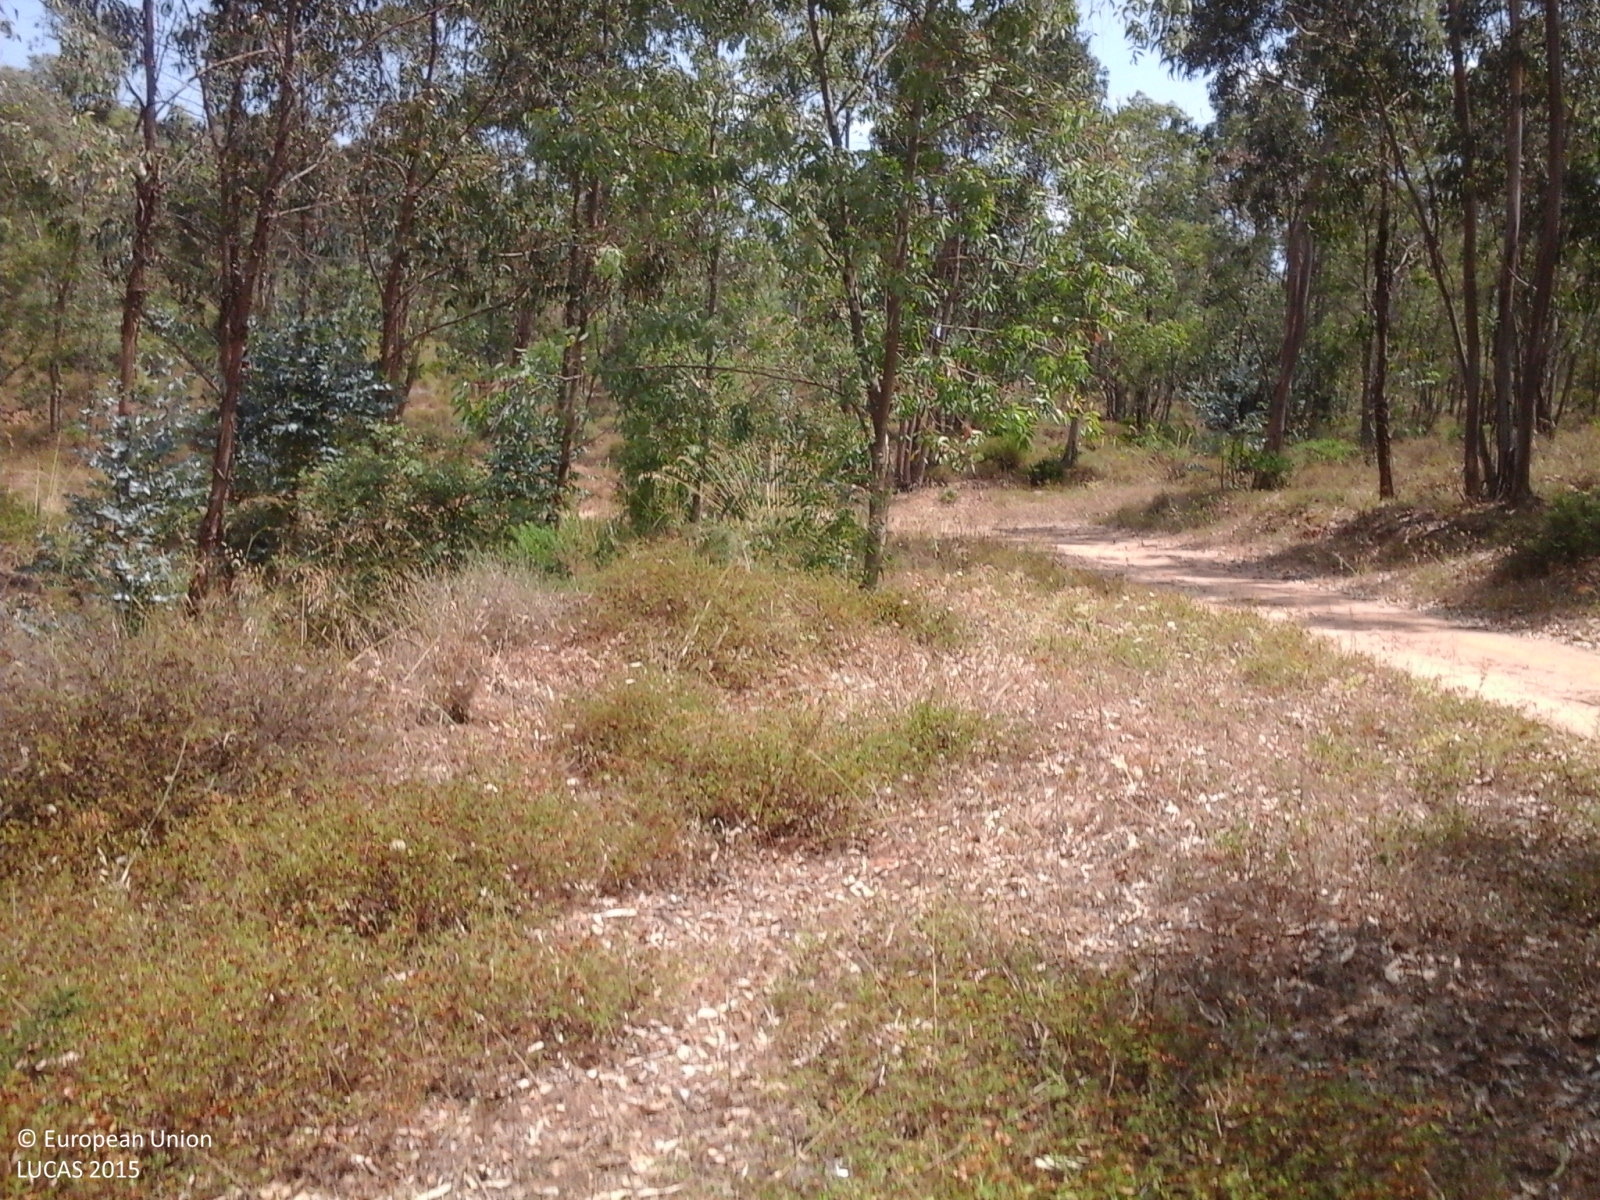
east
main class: Woodland
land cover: Broadleaved woodland
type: broadleaved evergreen forest
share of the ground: > 75 %
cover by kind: broadleaved forest trees 100 %
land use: Forestry
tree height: > 5 m
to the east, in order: Broadleaved woodland; Tracks; Broadleaved woodland; Tracks; Broadleaved woodland
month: July
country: IT
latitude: 37.2660
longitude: 14.3532
